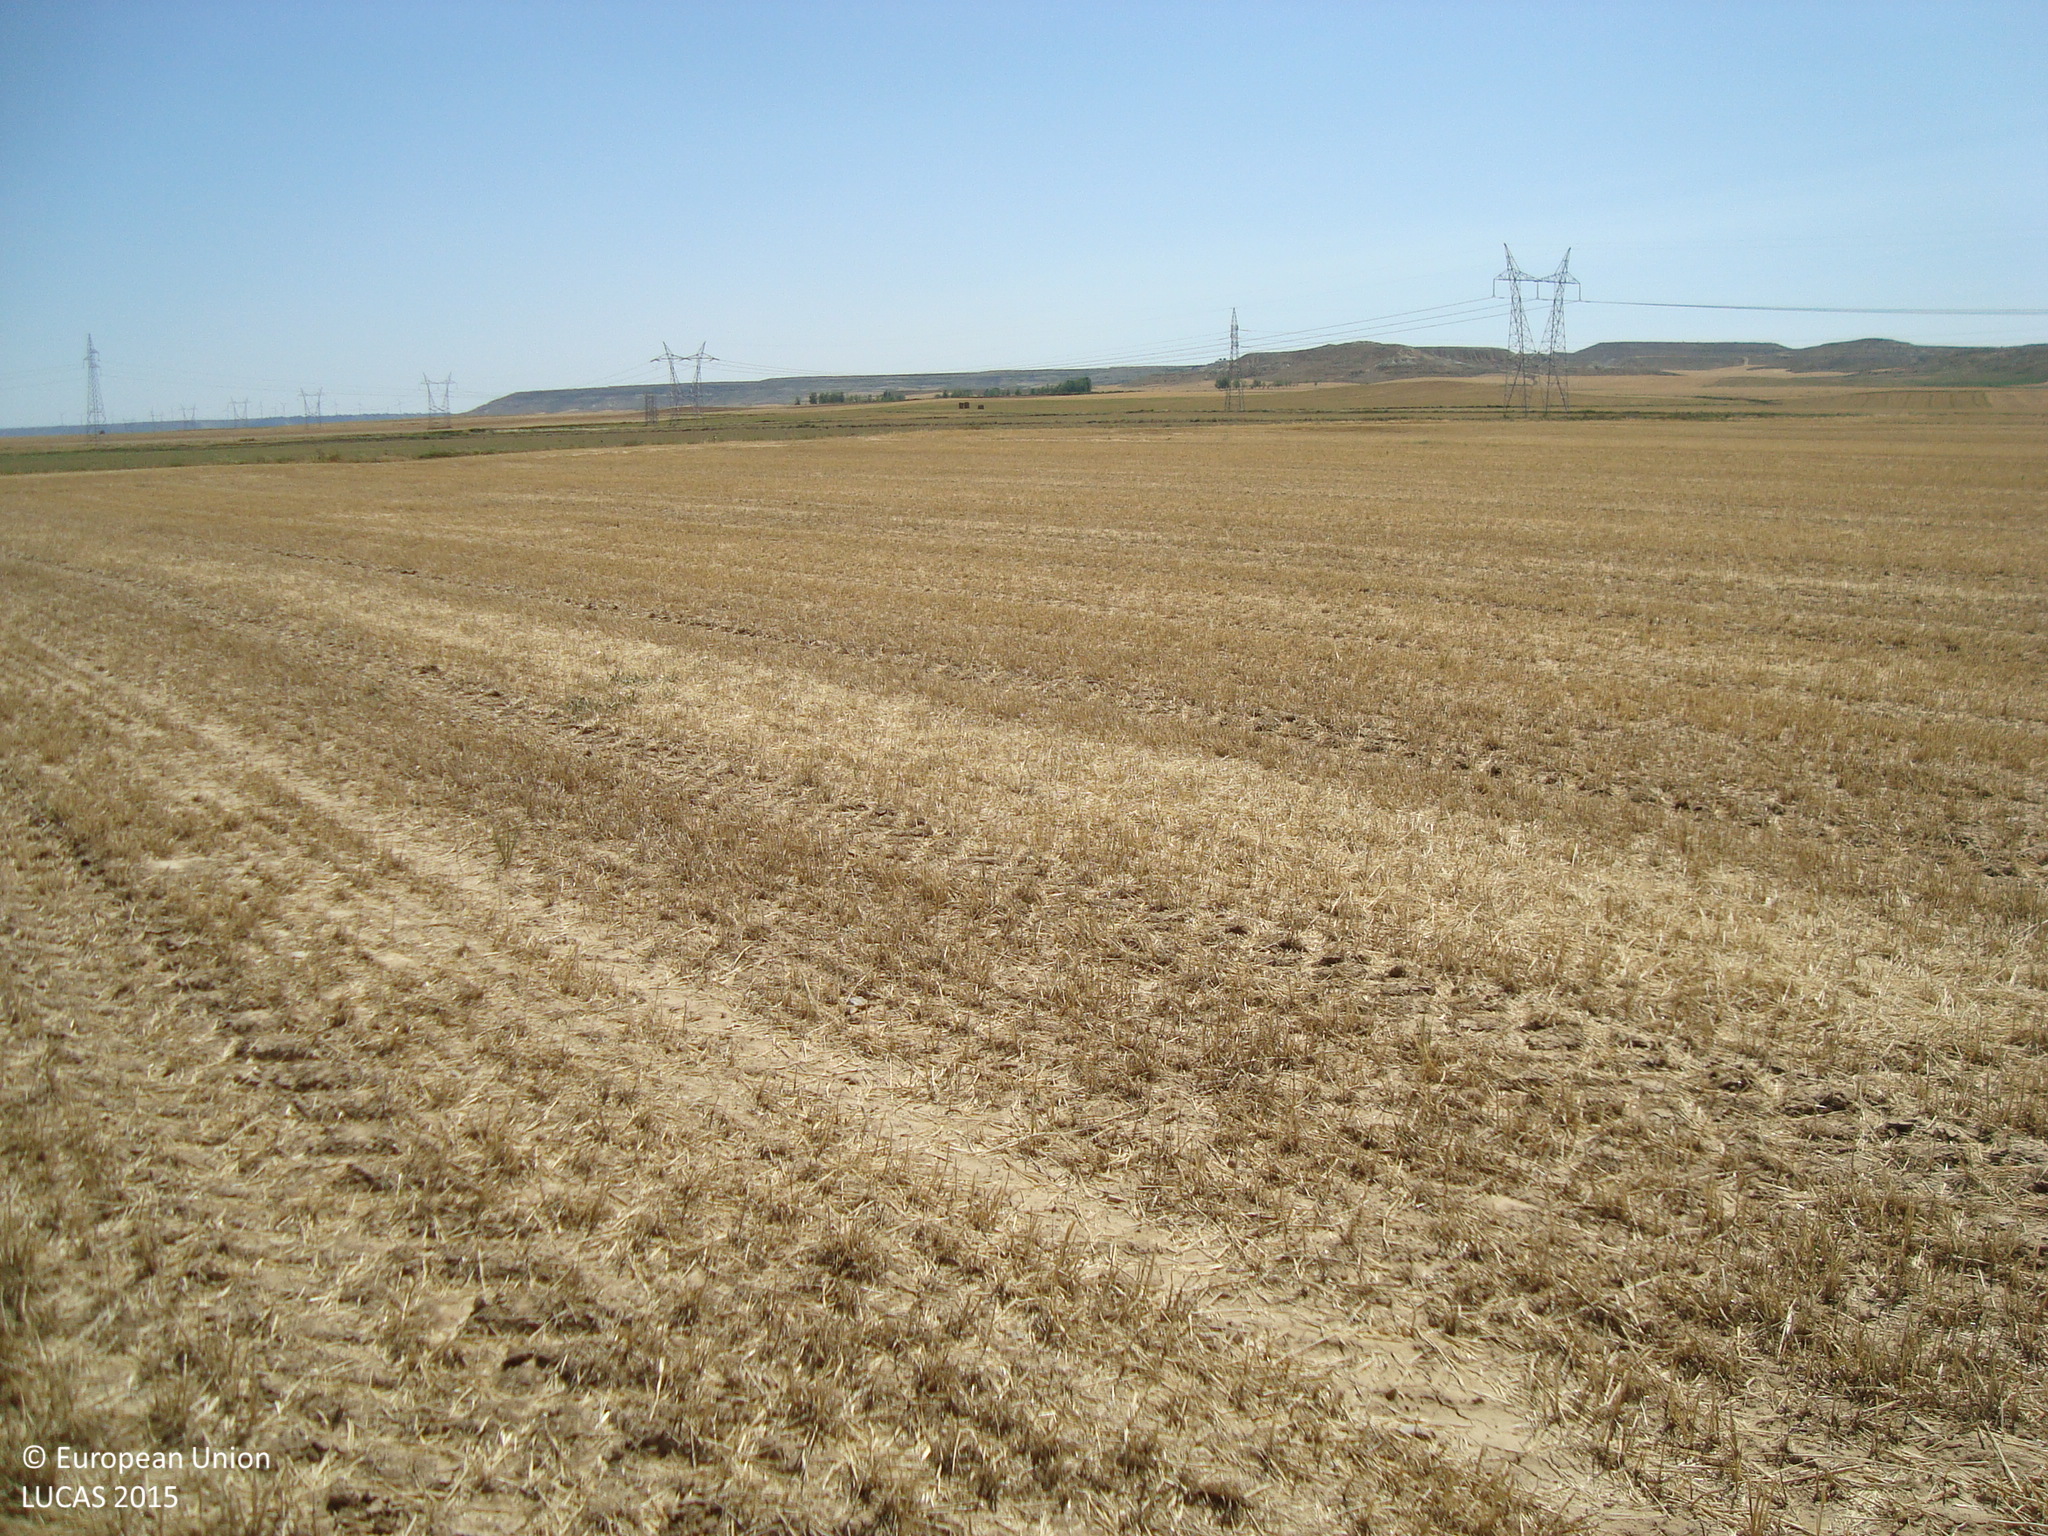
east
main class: Cropland
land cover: Barley
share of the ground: < 10 %
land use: Agriculture (excluding fallow land and kitchen gardens)
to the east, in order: Barley; Grass margins; Tracks; Grass margins; Lucerne; Rivers and streams; Lucerne
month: July
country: ES
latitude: 41.9974
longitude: -4.6924
